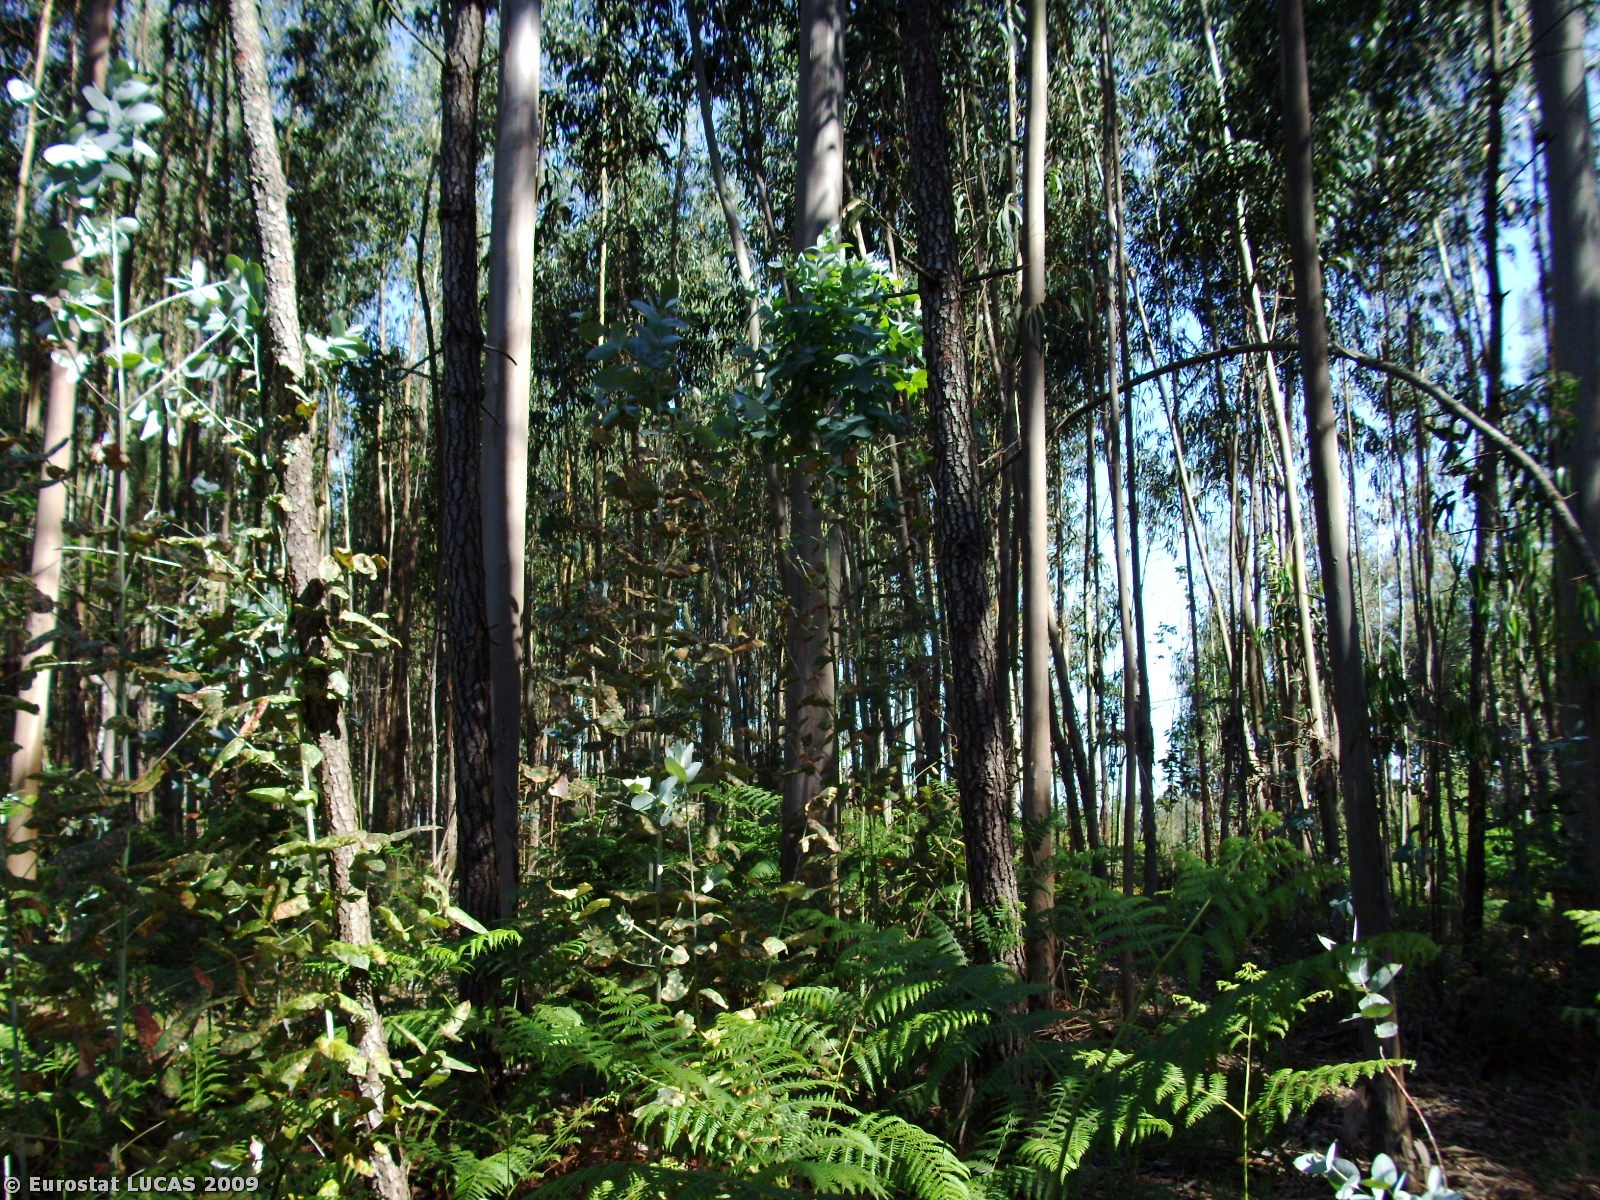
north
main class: Woodland
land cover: Broadleaved woodland
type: plantations and self-sown exotic forest
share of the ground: > 75 %
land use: Forestry
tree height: > 5 m
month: May
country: PT
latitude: 40.6708
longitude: -8.4156
